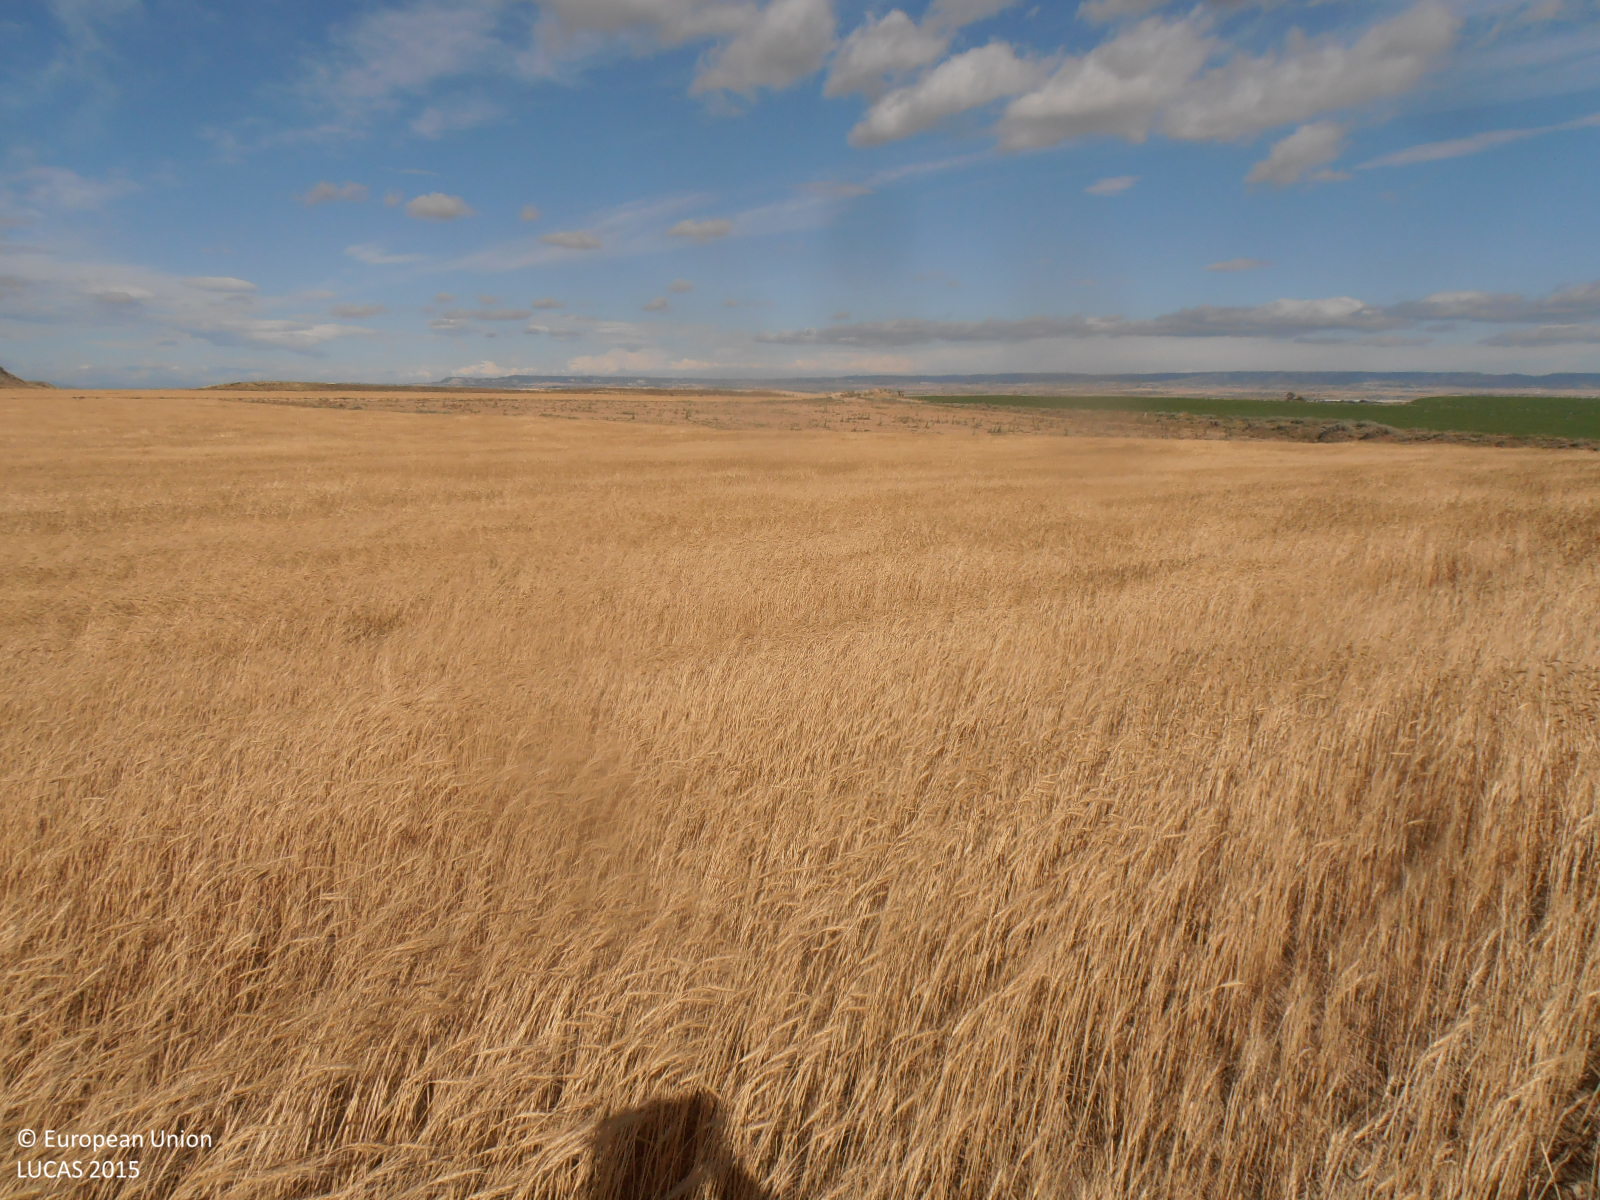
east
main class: Cropland
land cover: Common wheat
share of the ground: > 75 %
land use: Agriculture (excluding fallow land and kitchen gardens)
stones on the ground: < 10 %
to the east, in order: Common wheat; Grass margins; Tracks; Grass margins; Other bare soil
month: June
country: ES
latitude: 41.9995
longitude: -1.3166
